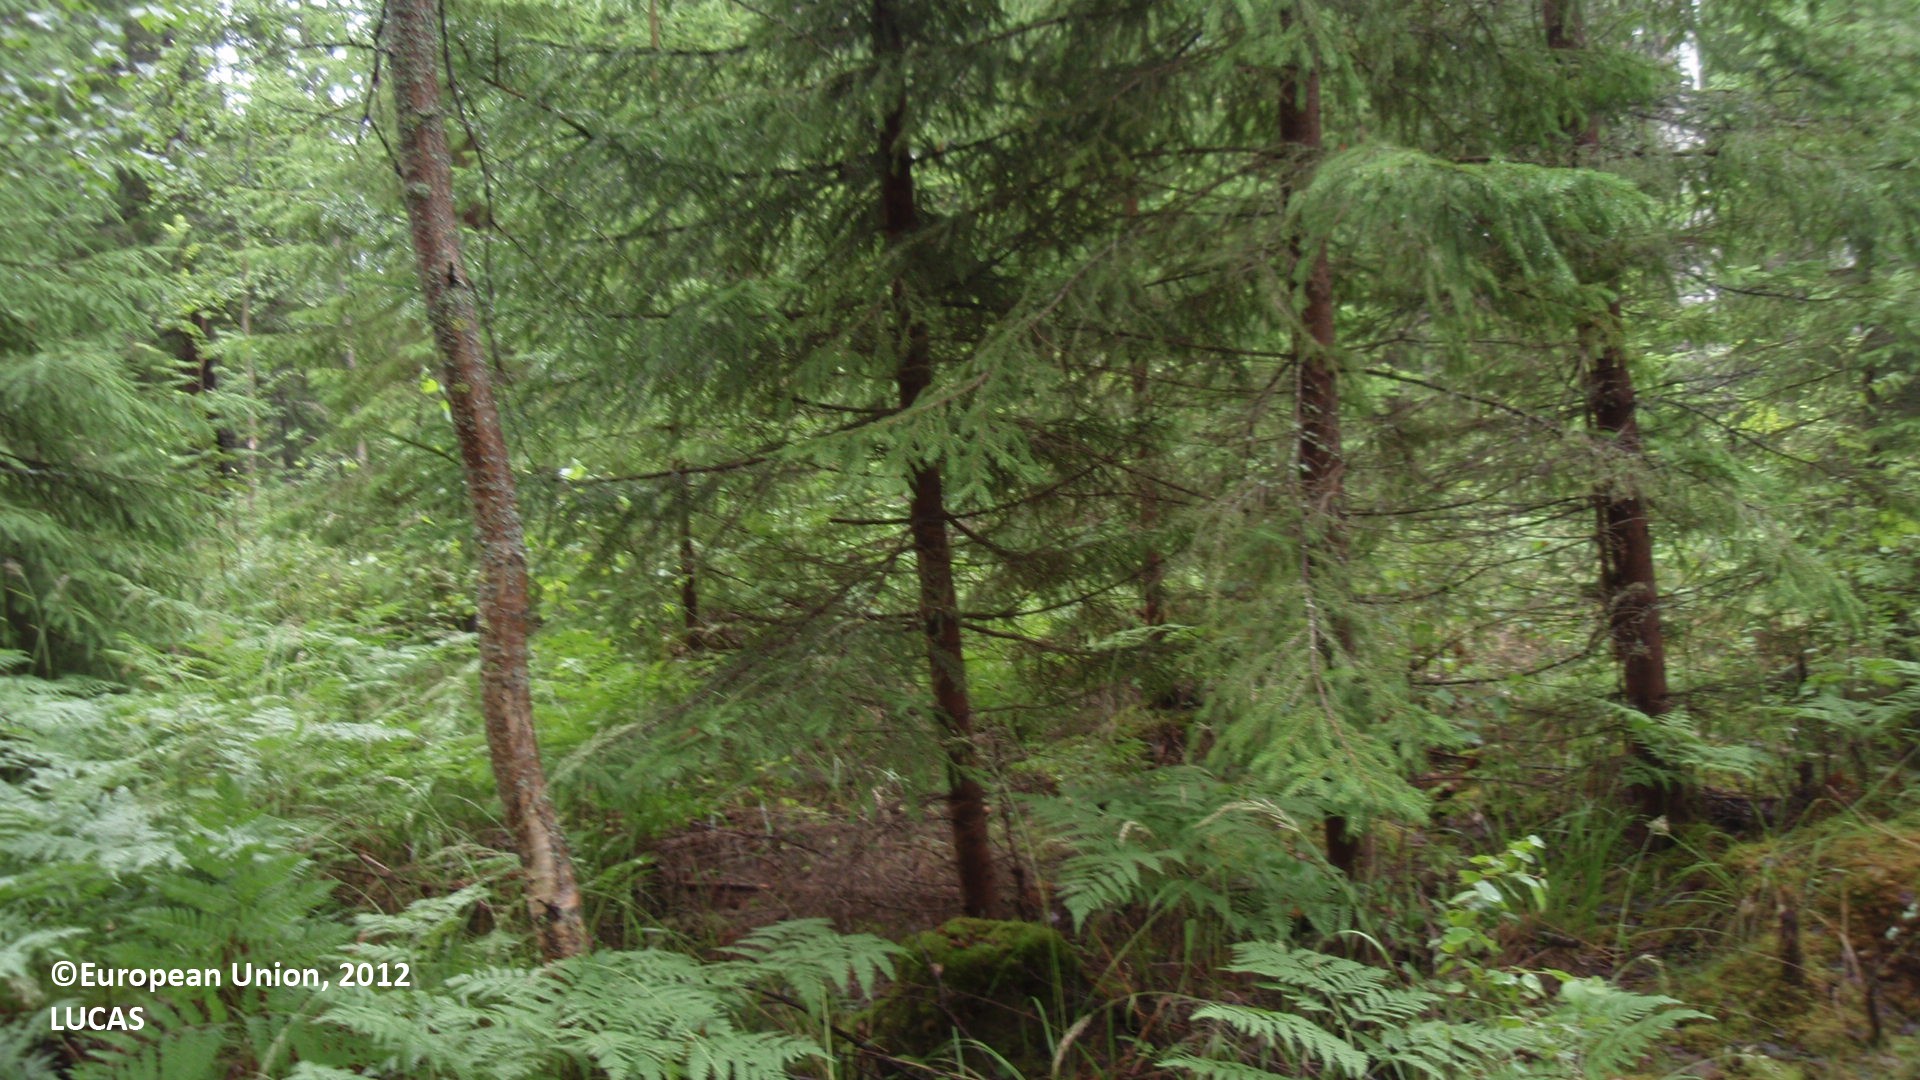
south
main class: Woodland
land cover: Spruce dominated mixed woodland
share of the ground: > 75 %
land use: Forestry
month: July
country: FI
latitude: 61.5852
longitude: 27.2553
